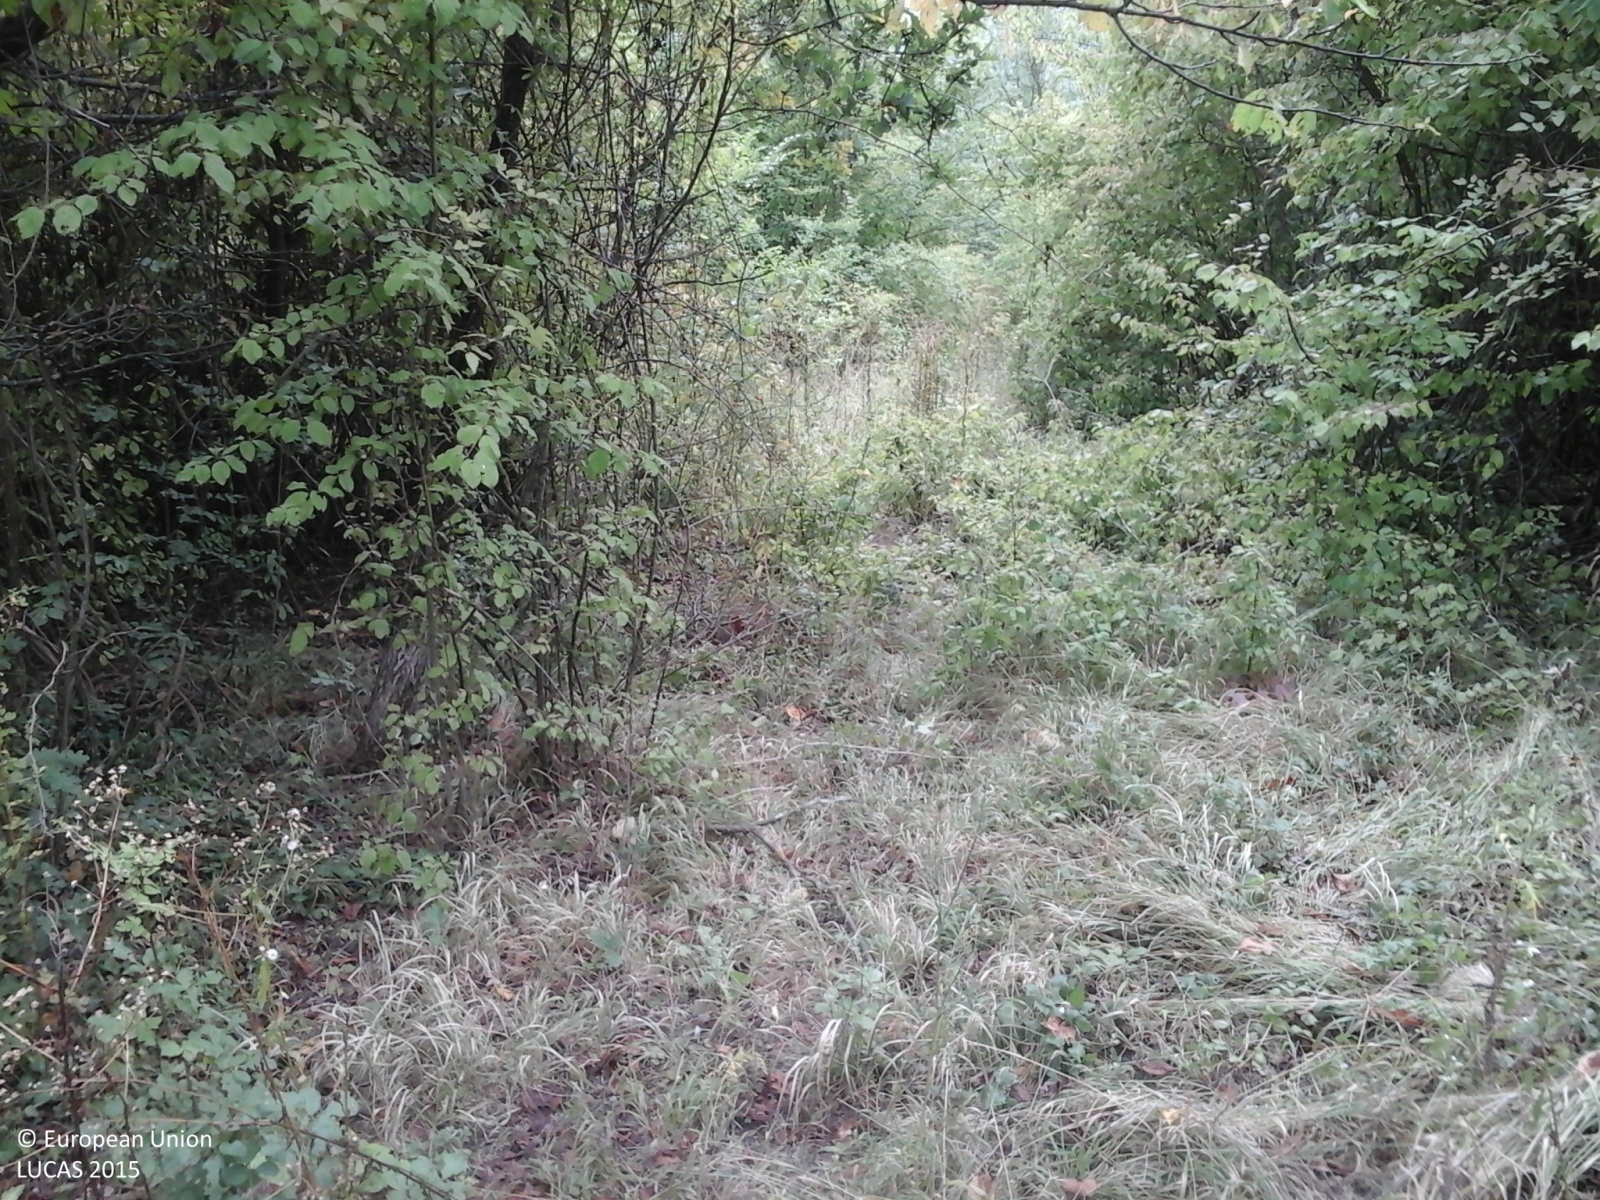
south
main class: Woodland
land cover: Broadleaved woodland
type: mesophytic deciduous forest
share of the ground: > 75 %
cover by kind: broadleaved forest trees 80 %, shrubs 15 %, herbaceous plants 5 %
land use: Forestry
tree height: > 5 m
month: August
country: IT
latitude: 44.9785
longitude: 9.1773
